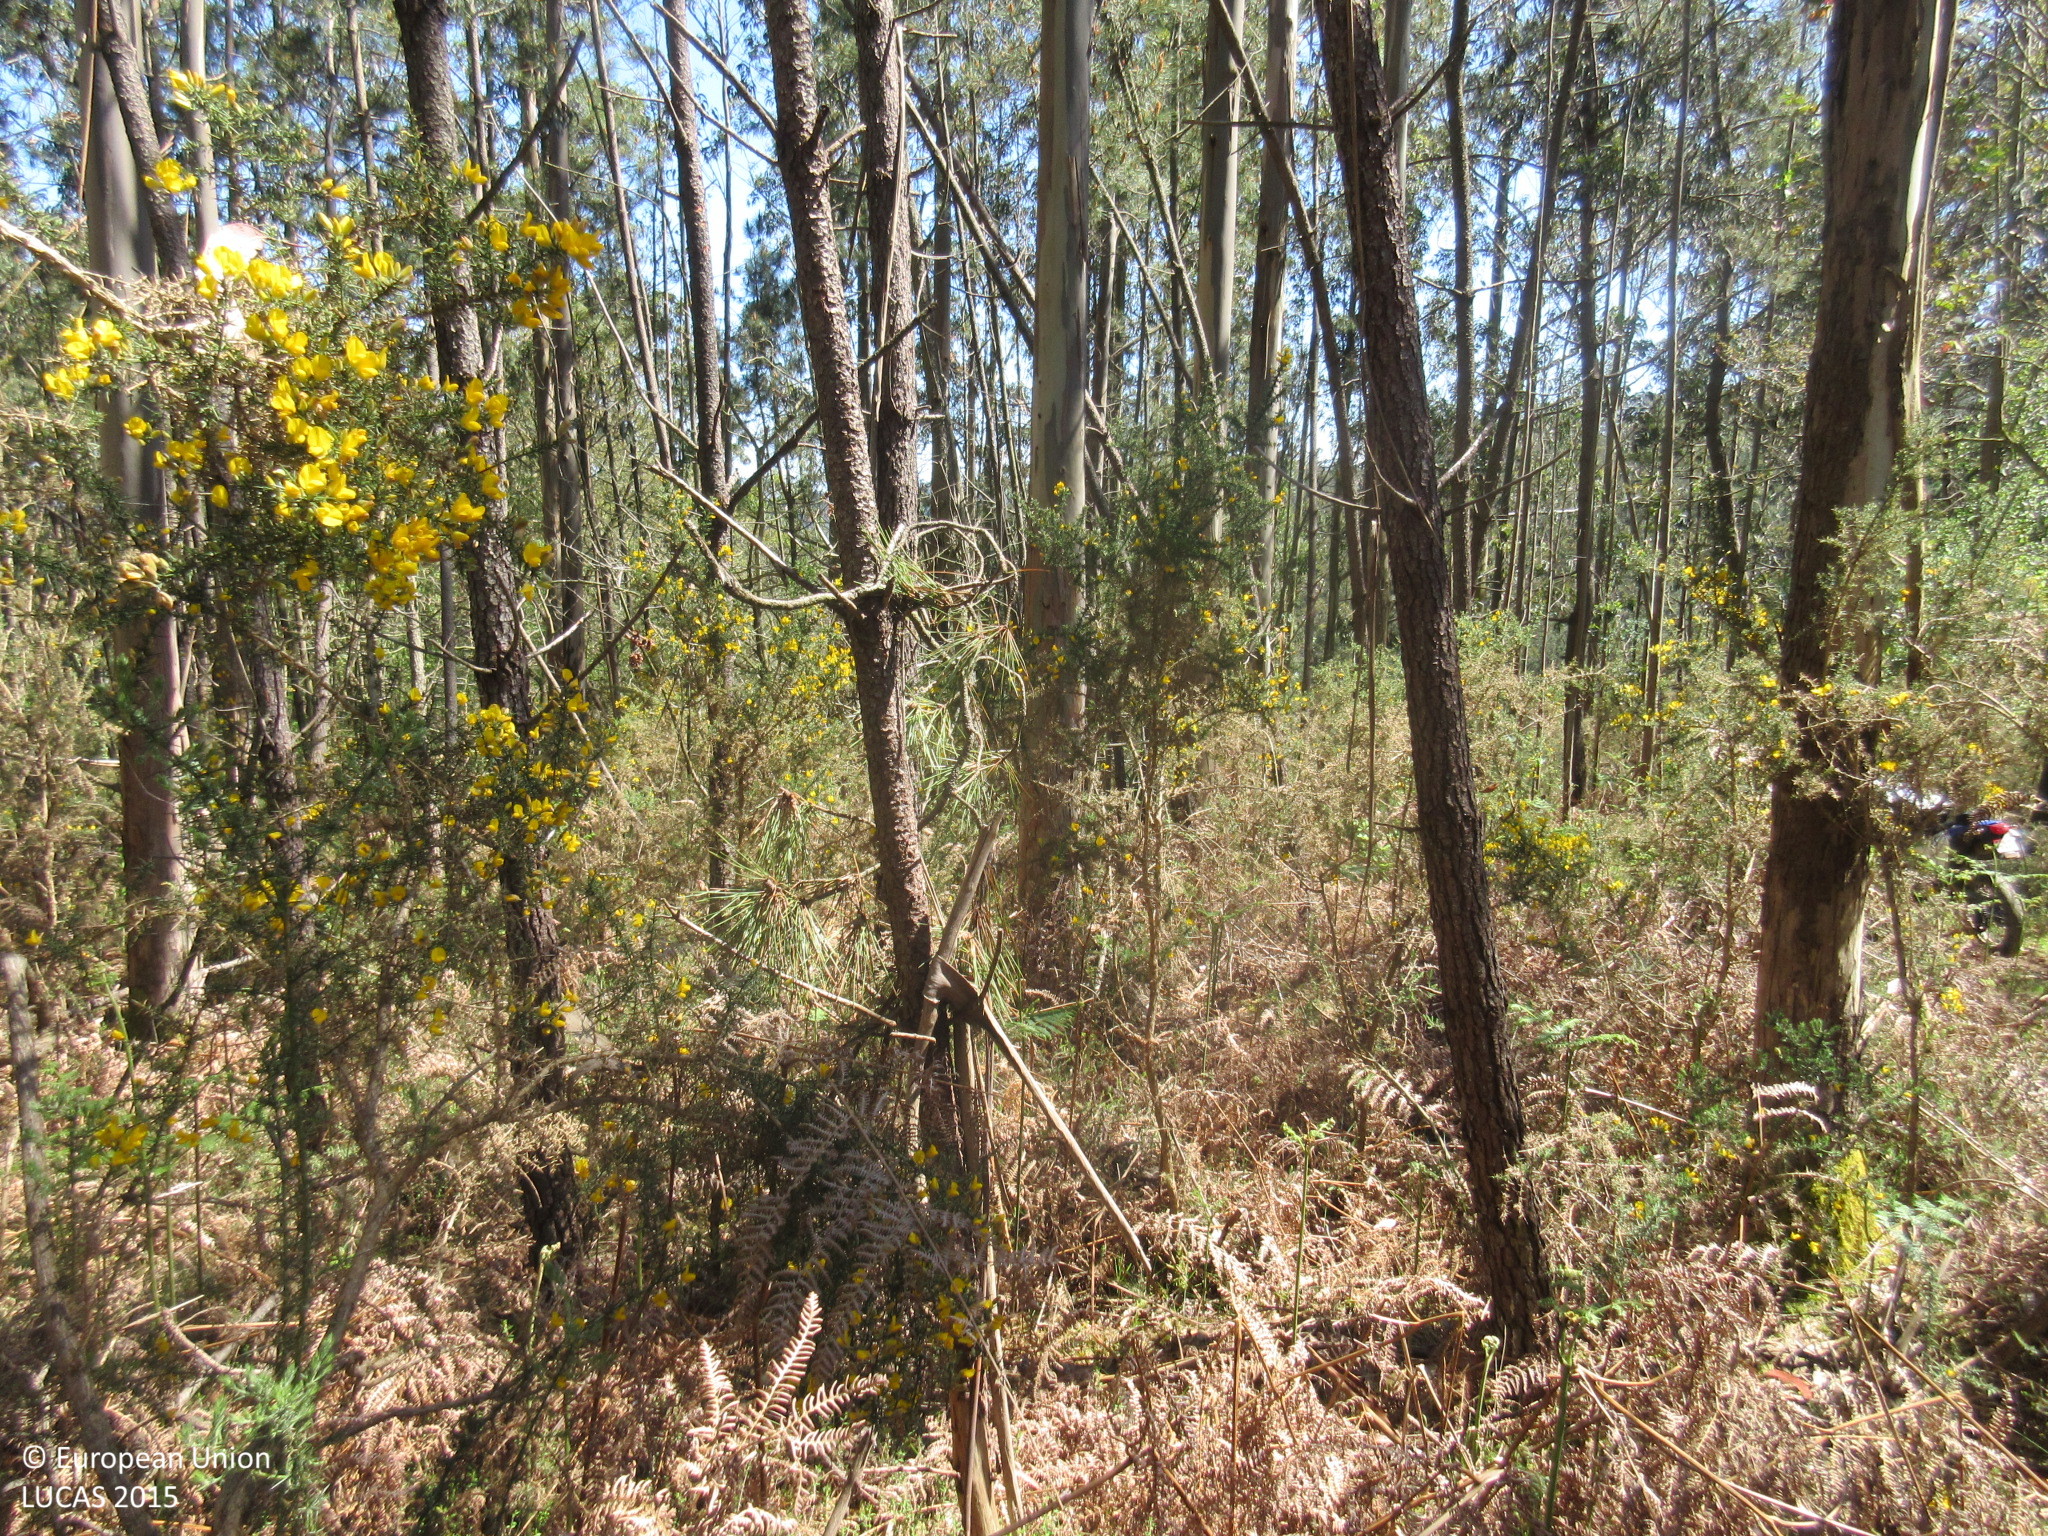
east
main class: Woodland
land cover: Other mixed woodland
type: exotic forest
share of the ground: > 75 %
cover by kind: broadleaved forest trees 50 %, coniferous forest trees 45 %, shrubs 5 %
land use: Forestry
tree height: > 5 m
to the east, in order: Other mixed woodland; Grassland without tree/shrub cover; Broadleaved woodland; Rivers and streams; Broadleaved woodland
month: April
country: ES
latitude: 43.5056
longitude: -7.0007
